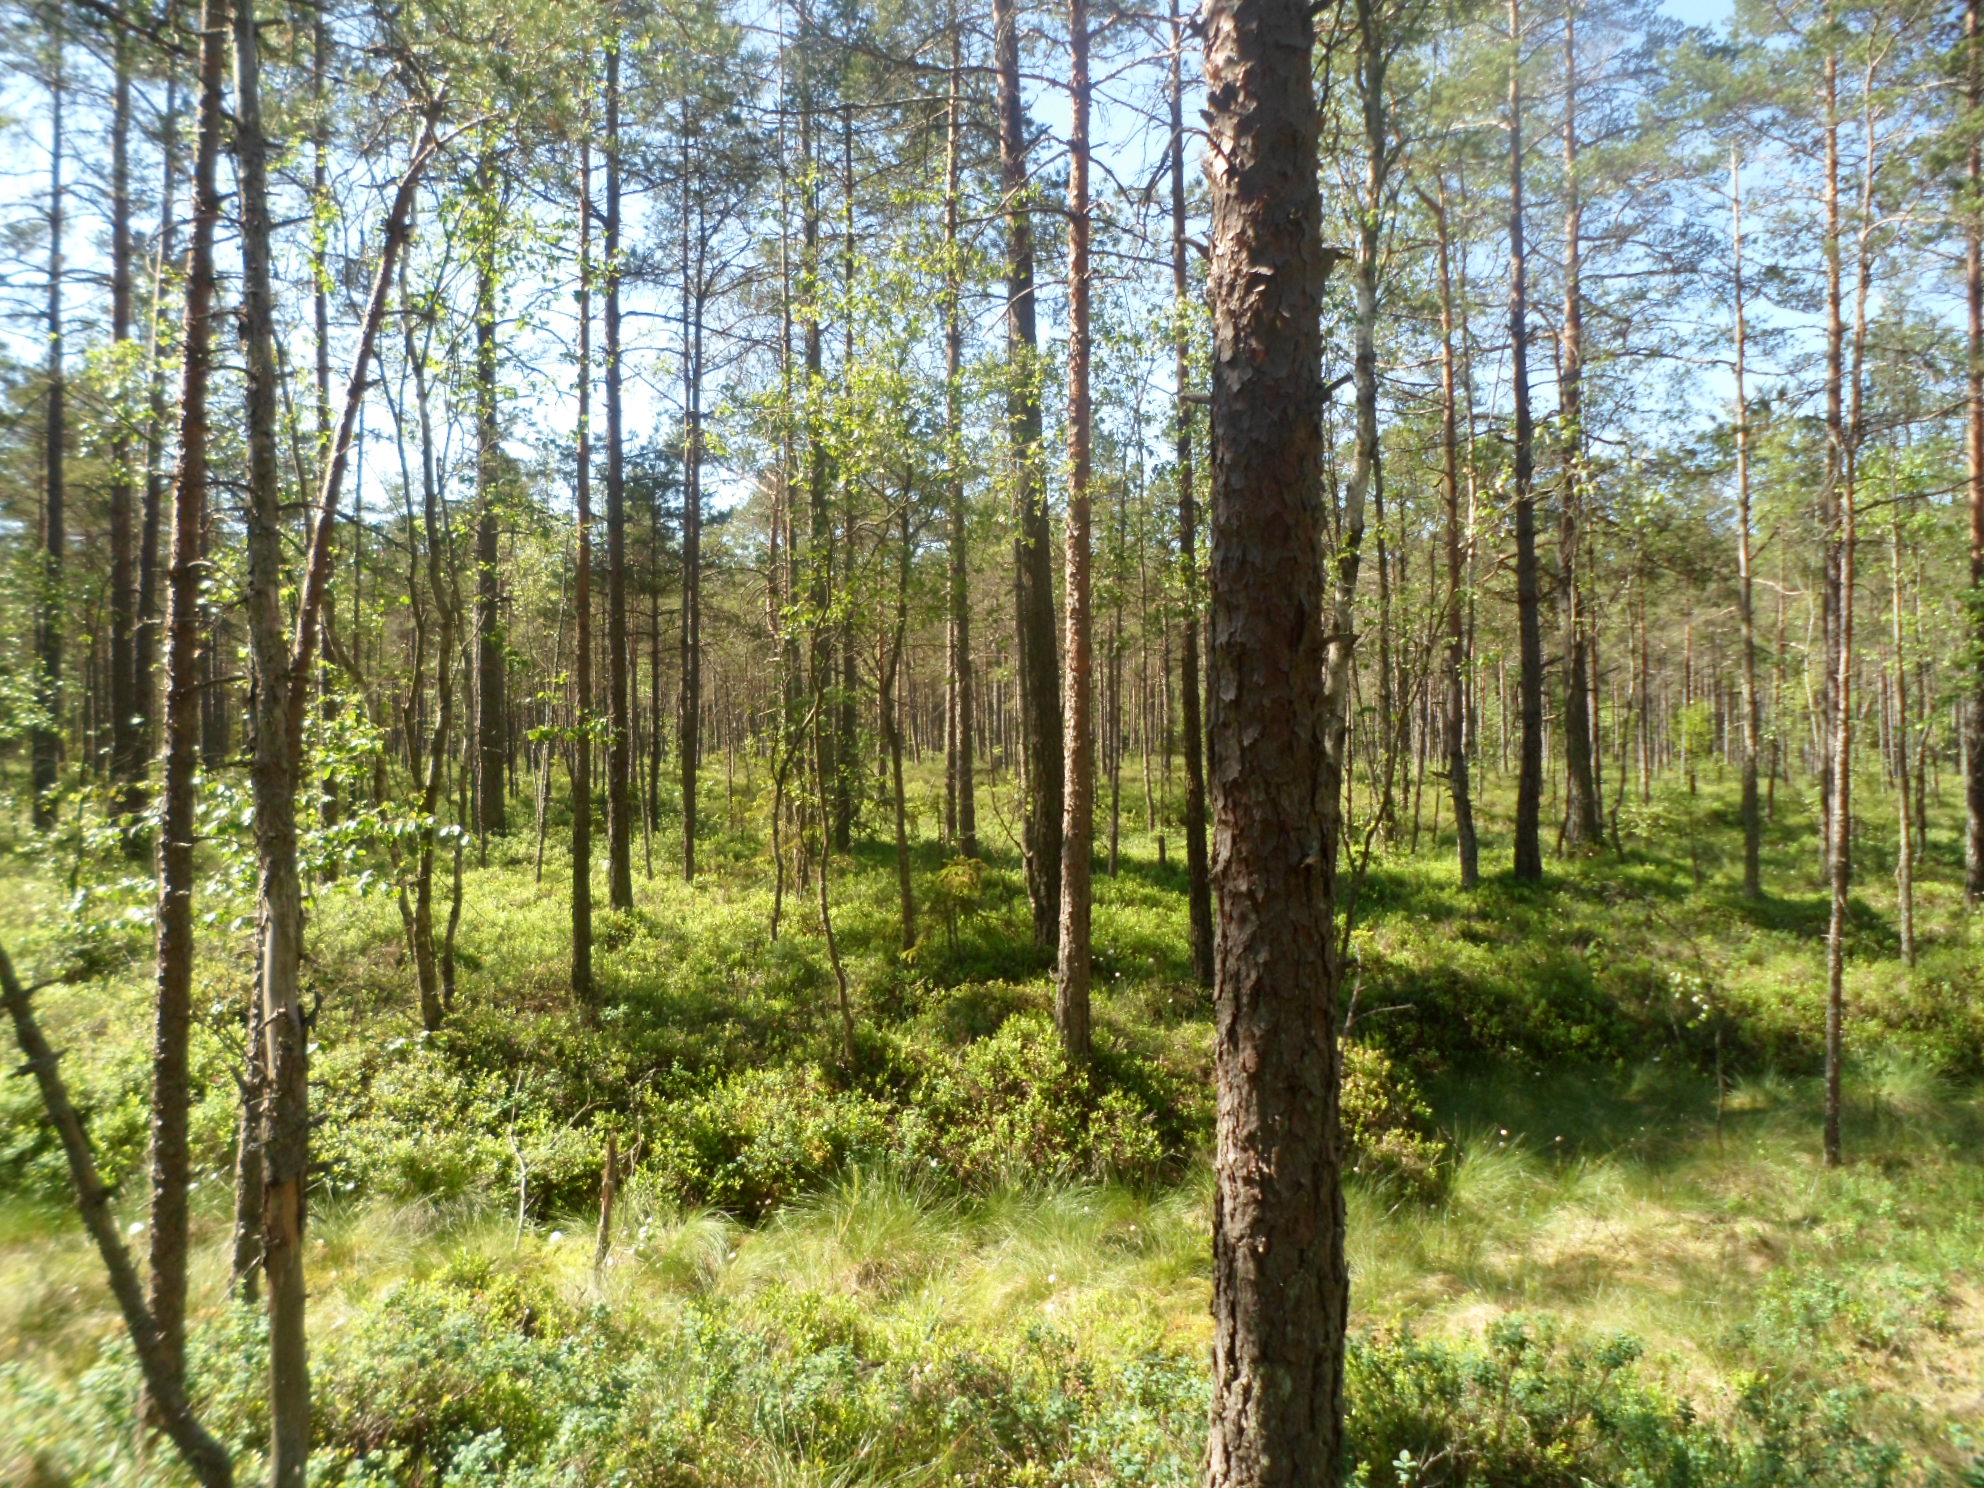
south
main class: Woodland
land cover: Pine dominated coniferous woodland
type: boreal forest
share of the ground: 50 - 75 %
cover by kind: coniferous forest trees 55 %, shrubs 30 %, broadleaved forest trees 5 %, herbaceous plants 5 %, lichens and mosses 5 %
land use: Forestry
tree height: > 5 m
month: July
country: SE
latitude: 57.4390
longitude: 14.5772
